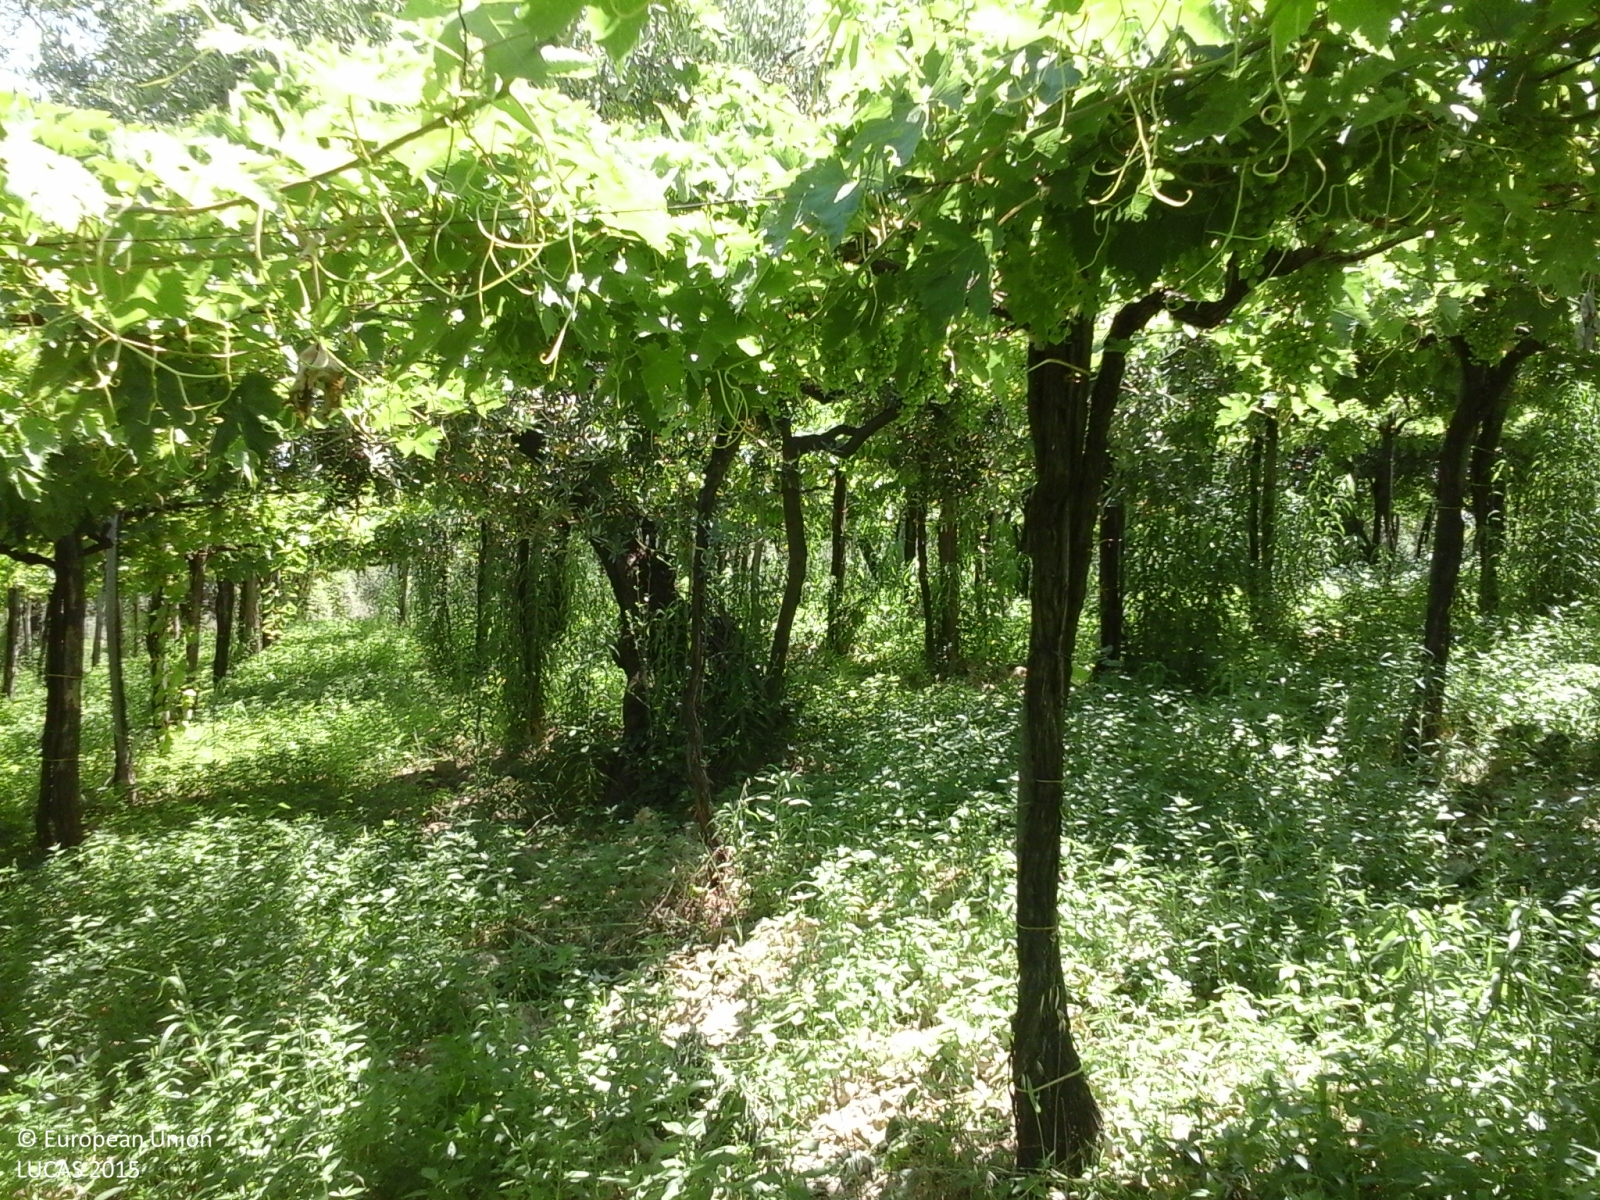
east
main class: Cropland
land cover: Vineyards
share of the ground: 25 - 50 %
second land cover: Spontaneously vegetated surfaces
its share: 25 - 50 %
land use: Agriculture (excluding fallow land and kitchen gardens)
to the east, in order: Vineyards; Spontaneously vegetated surfaces; Olive groves; Vineyards; Other fruit trees and berries; Tracks; Electric lines; Olive groves; Vineyards; Single bushes/trees; Shrubland with sparse tree cover; Olive groves; Shrubland with sparse tree cover
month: July
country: IT
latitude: 42.2907
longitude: 14.3167
